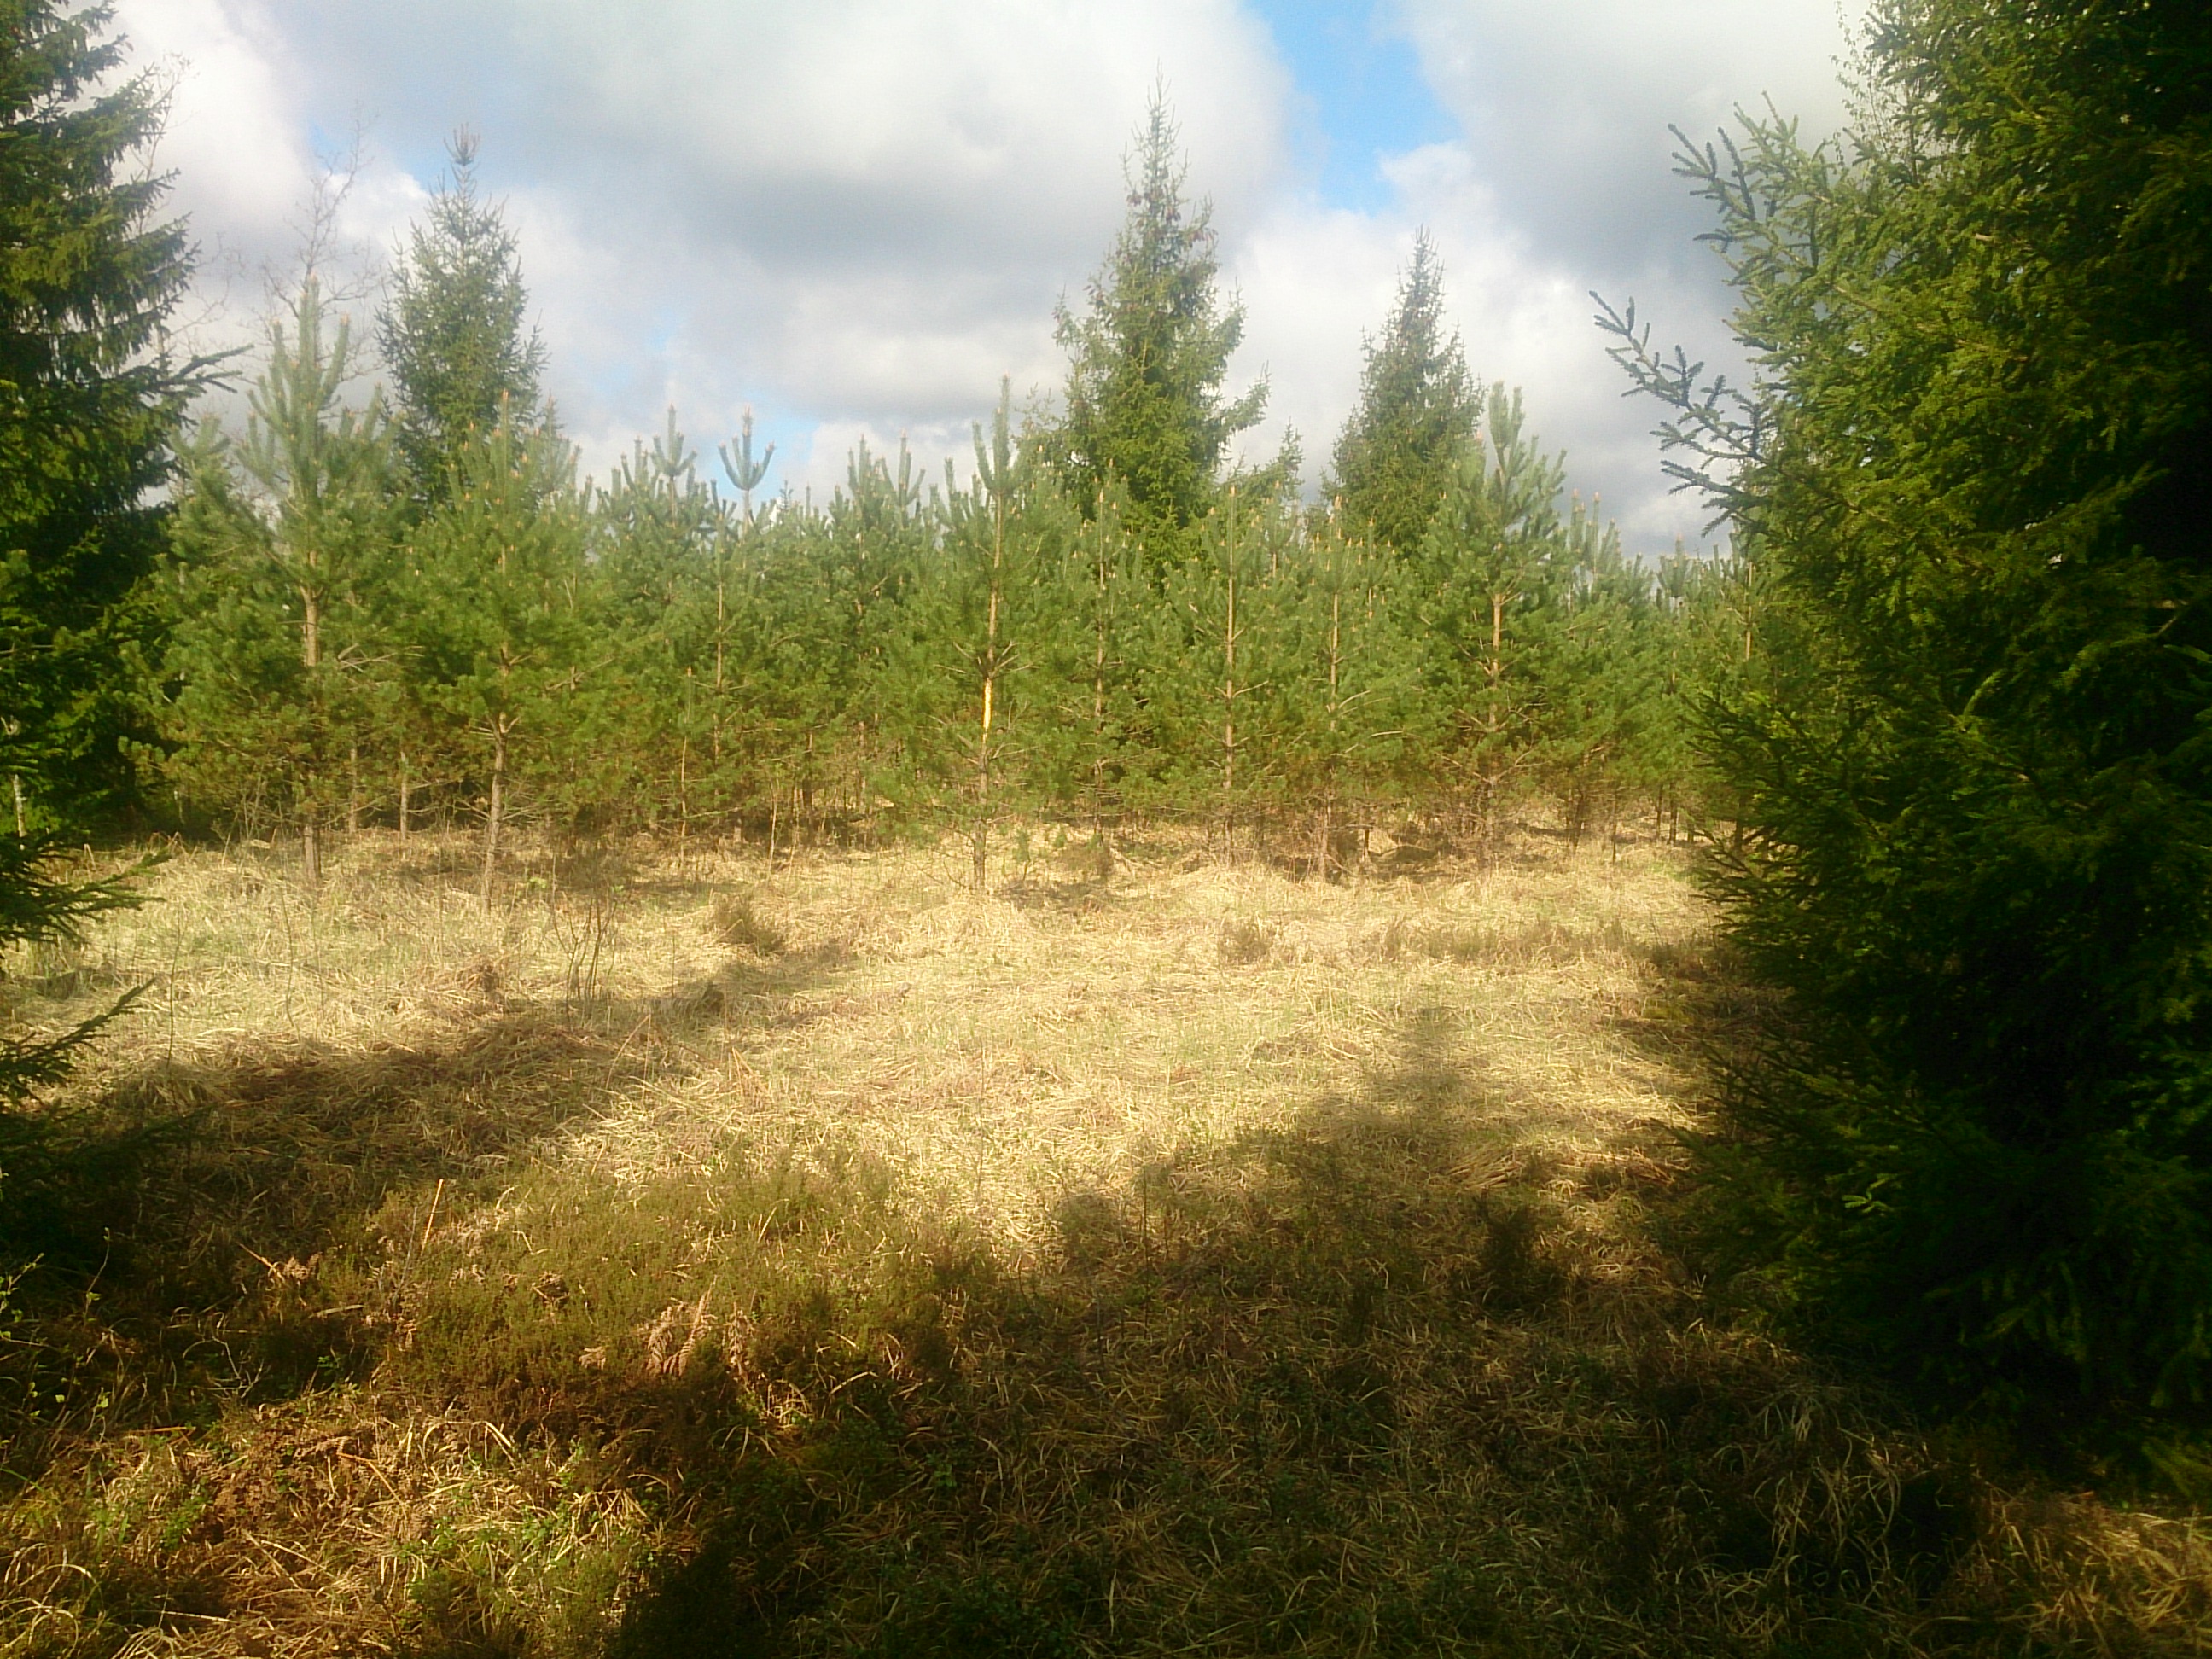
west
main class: Woodland
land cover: Spruce dominated mixed woodland
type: hemiboreal forest and nemoral coniferous forest and mixed broadleaved-coniferous forest
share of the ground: 50 - 75 %
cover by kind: herbaceous plants 50 %, coniferous forest trees 30 %, broadleaved forest trees 20 %
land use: Forestry
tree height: > 5 m
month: May
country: LV
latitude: 56.7814
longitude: 24.2129
